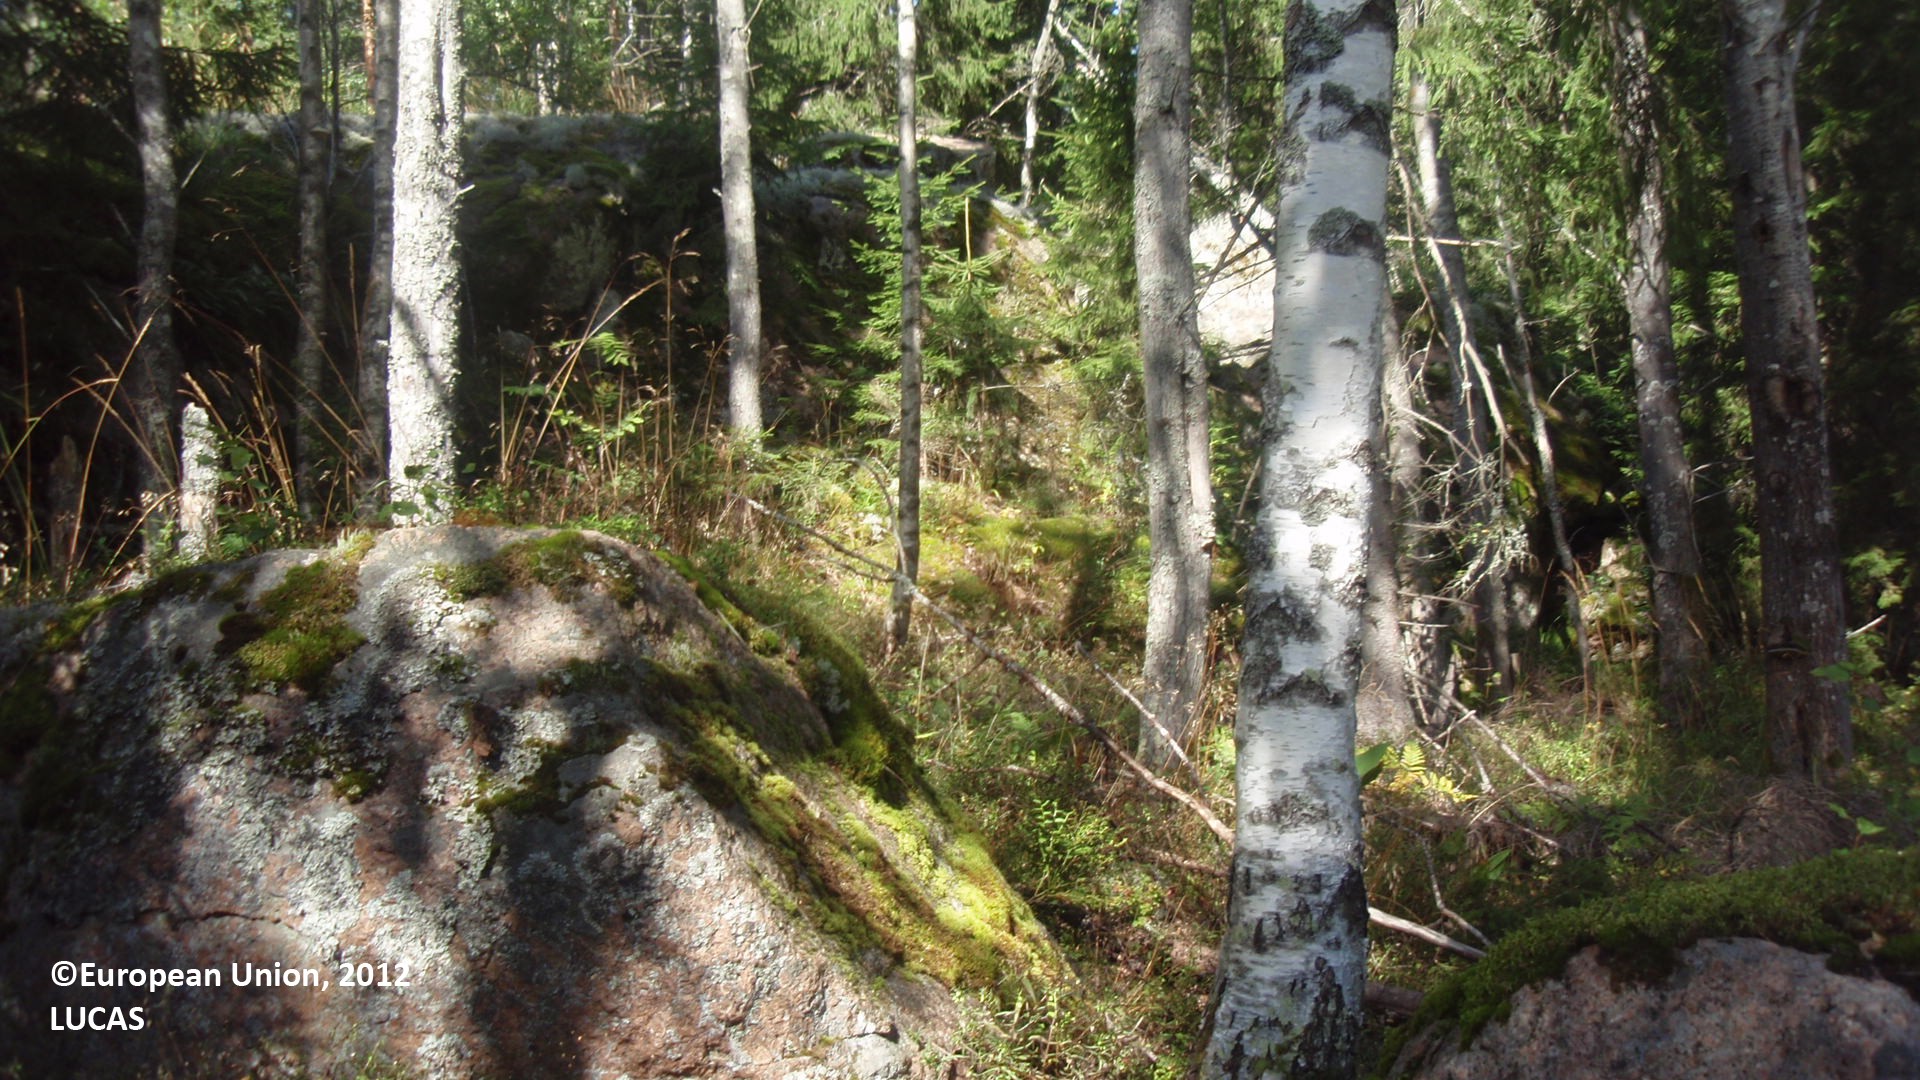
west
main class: Woodland
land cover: Spruce dominated mixed woodland
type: boreal forest
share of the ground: 50 - 75 %
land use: Forestry
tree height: > 5 m
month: August
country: FI
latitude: 60.5683
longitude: 27.3863
